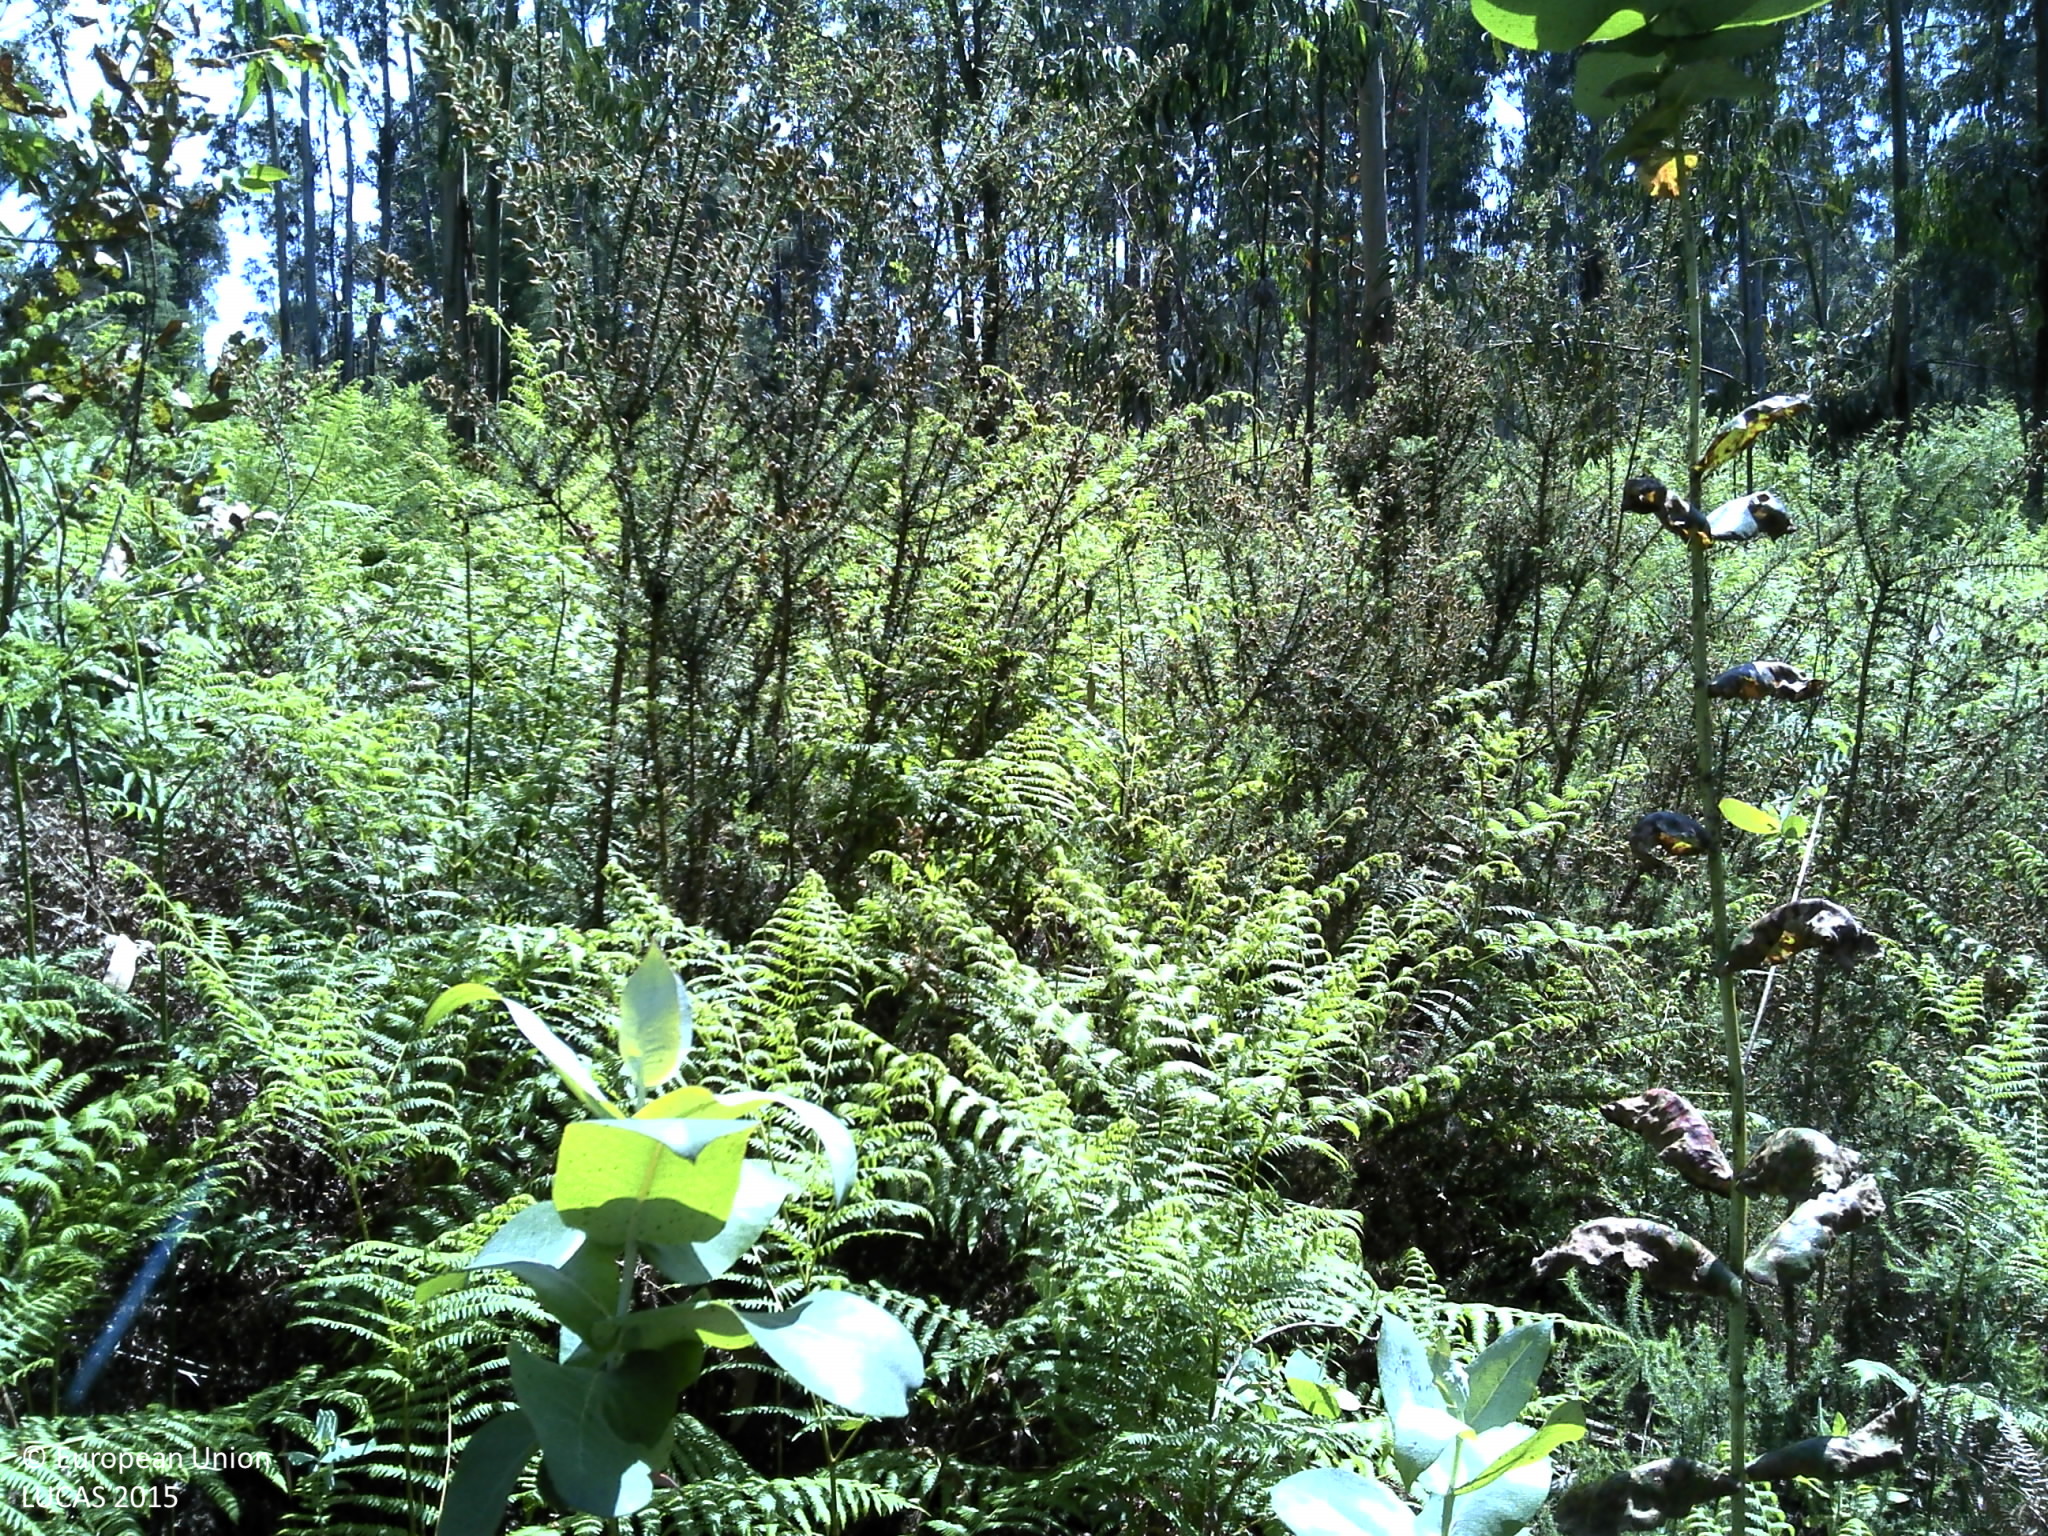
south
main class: Woodland
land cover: Broadleaved woodland
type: exotic forest
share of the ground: 50 - 75 %
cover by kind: broadleaved forest trees 70 %, shrubs 30 %
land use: Forestry
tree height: > 5 m
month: May
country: PT
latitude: 41.2564
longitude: -8.5441
